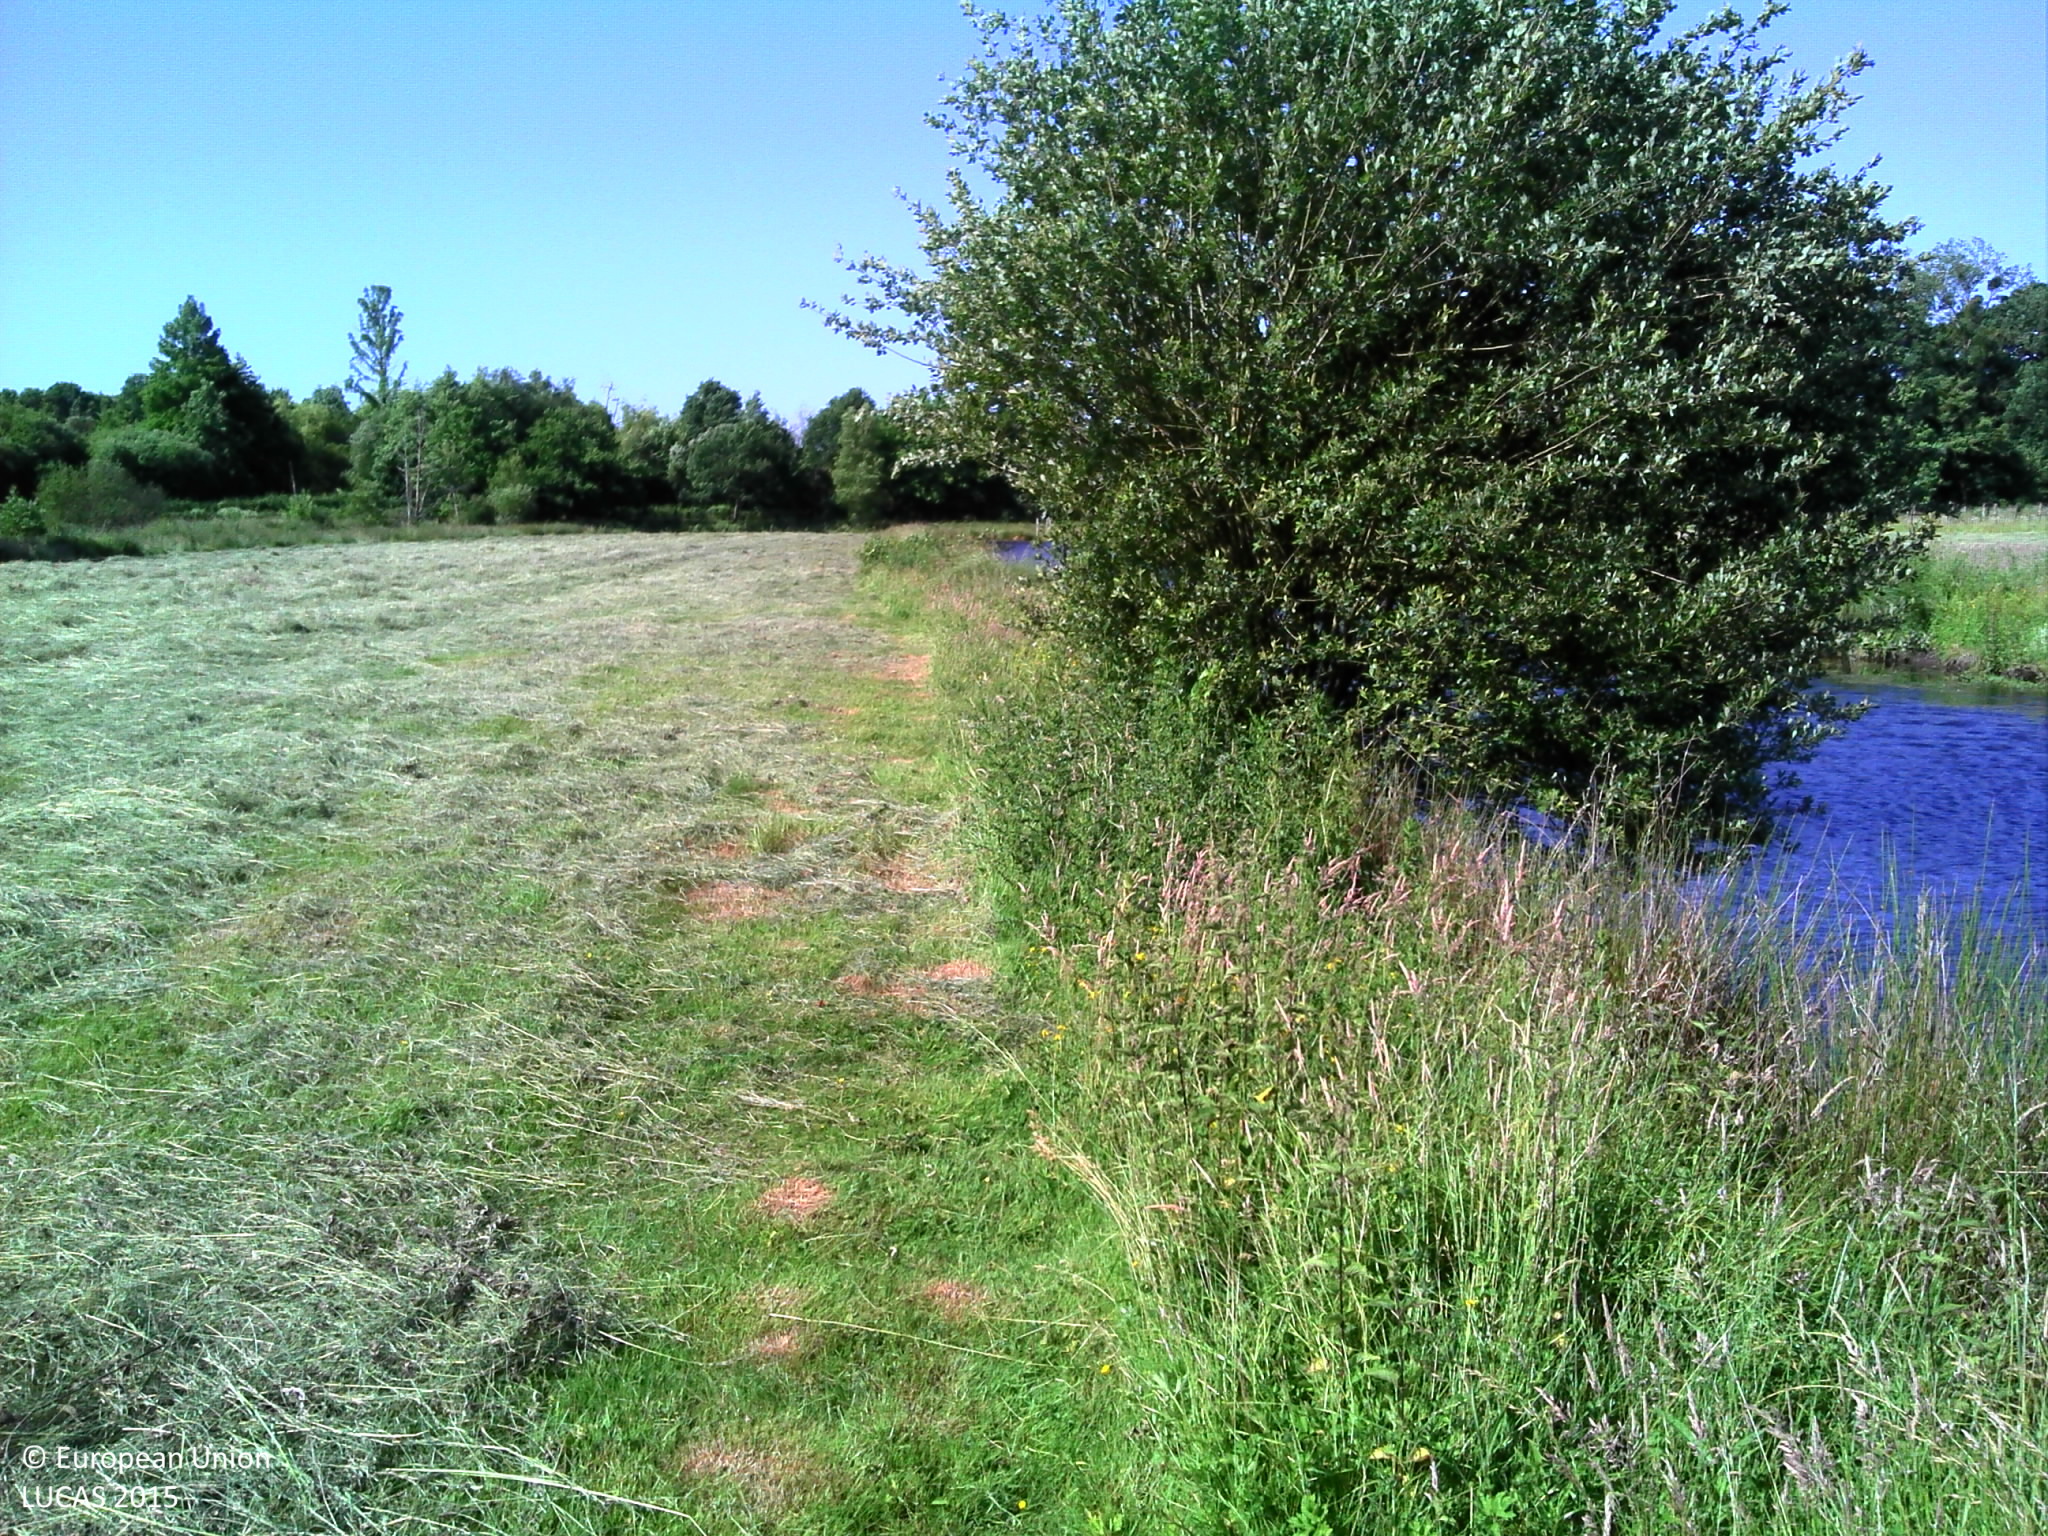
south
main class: Grassland
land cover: Grassland without tree/shrub cover
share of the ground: > 75 %
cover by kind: herbaceous plants 100 %
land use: Agriculture (excluding fallow land and kitchen gardens)
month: June
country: FR
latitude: 47.3299
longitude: -1.4881
